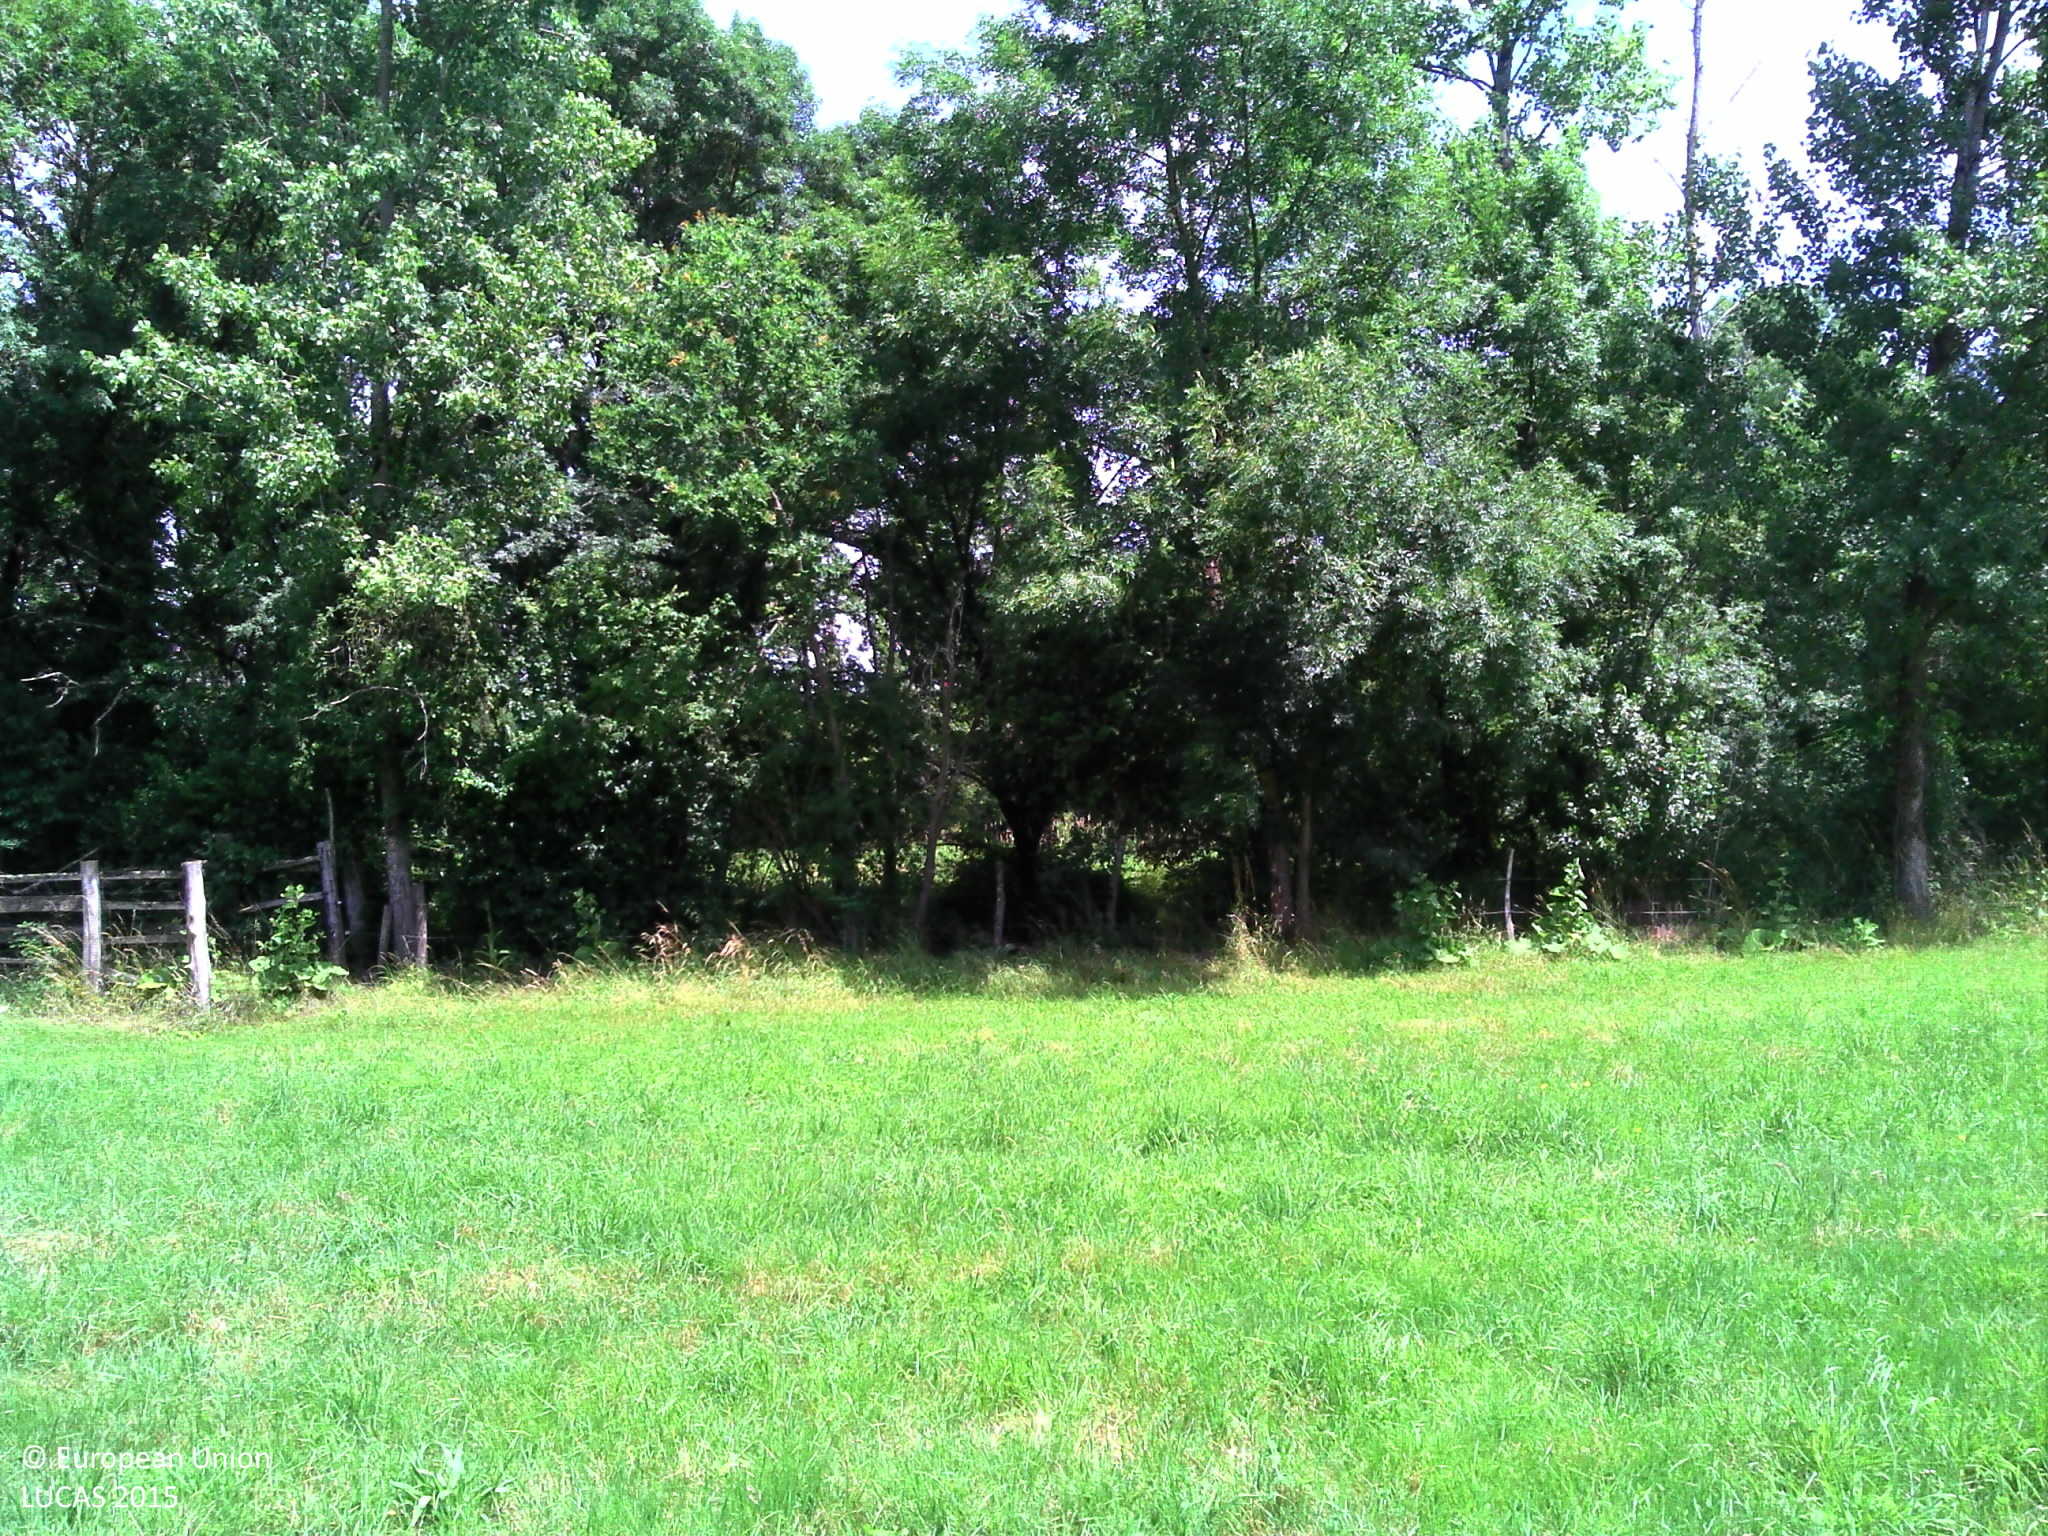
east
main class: Grassland
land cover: Grassland without tree/shrub cover
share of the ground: > 75 %
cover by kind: herbaceous plants 100 %
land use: Agriculture (excluding fallow land and kitchen gardens)
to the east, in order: Grassland without tree/shrub cover; Fences; Groves; Rivers and streams; Groves; Maize; Groves; Fences; Grassland without tree/shrub cover; Fences; Grassland without tree/shrub cover
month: June
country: FR
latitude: 45.6954
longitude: 0.3404
